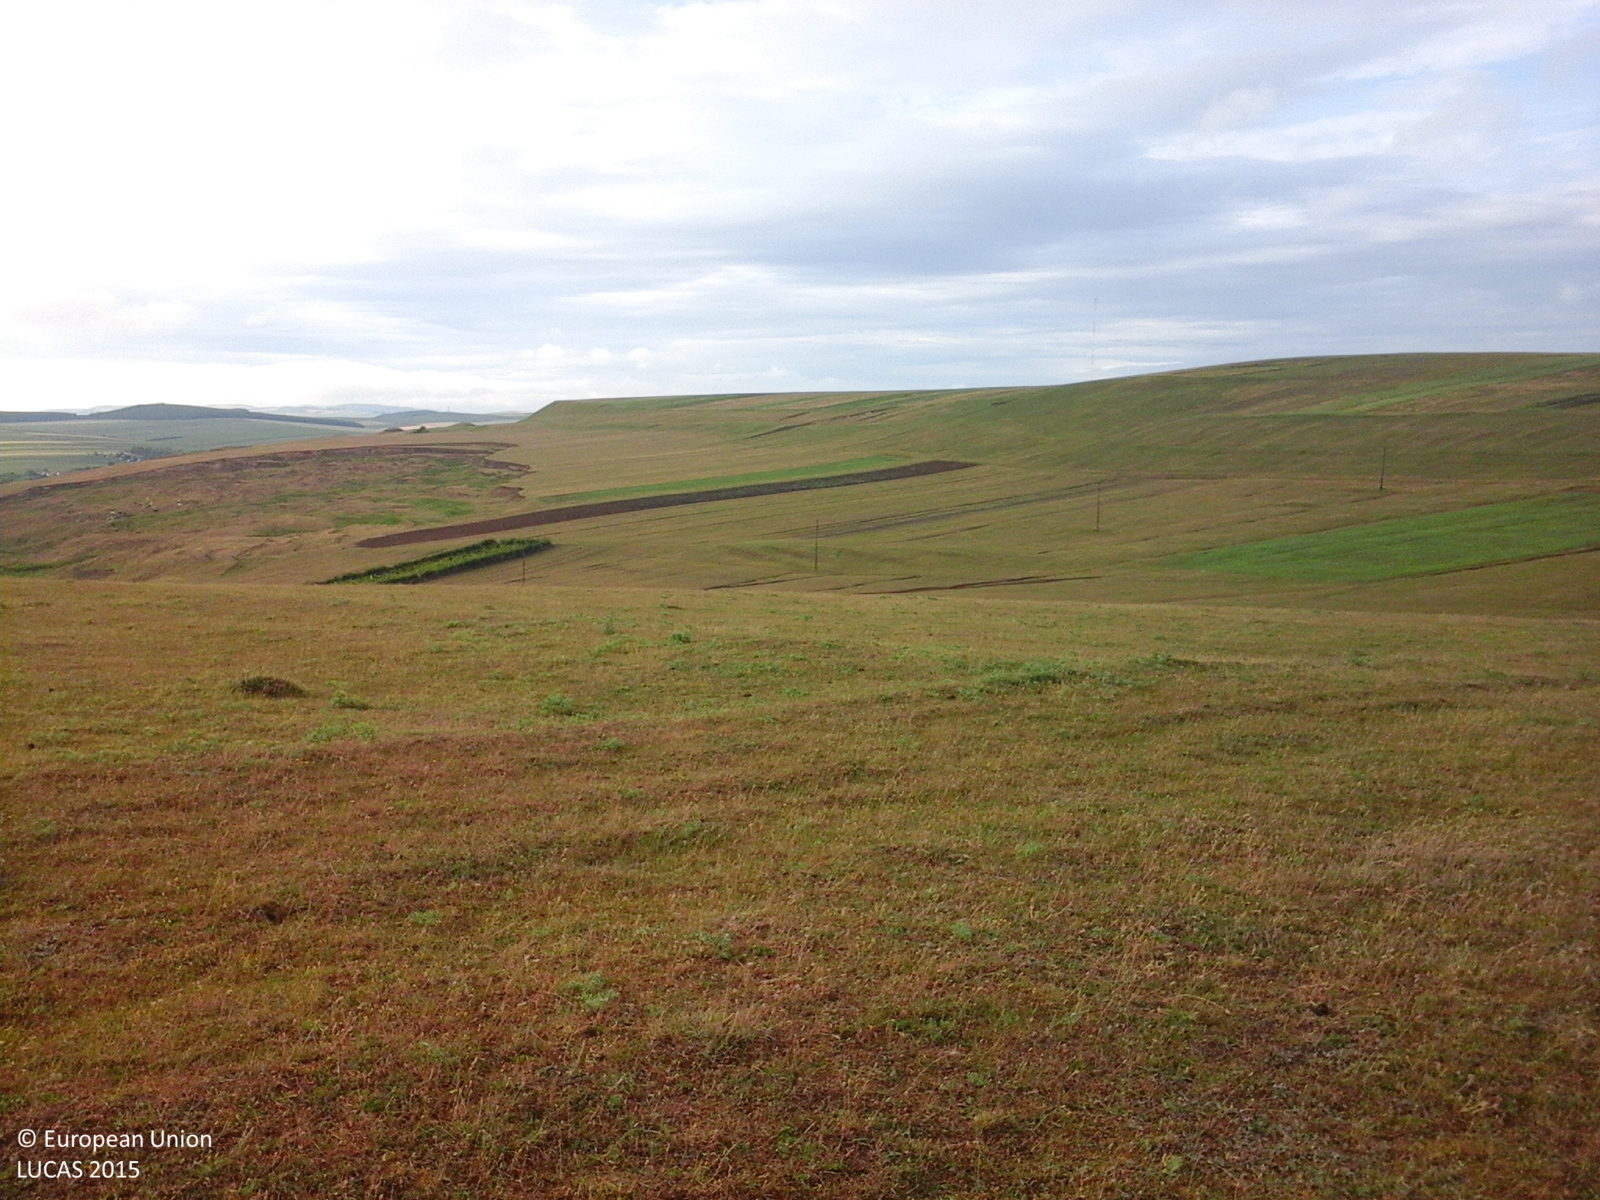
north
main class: Grassland
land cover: Grassland without tree/shrub cover
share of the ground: > 75 %
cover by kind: herbaceous plants 100 %
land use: Agriculture (excluding fallow land and kitchen gardens)
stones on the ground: < 10 %
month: June
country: RO
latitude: 47.2510
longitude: 26.8104
